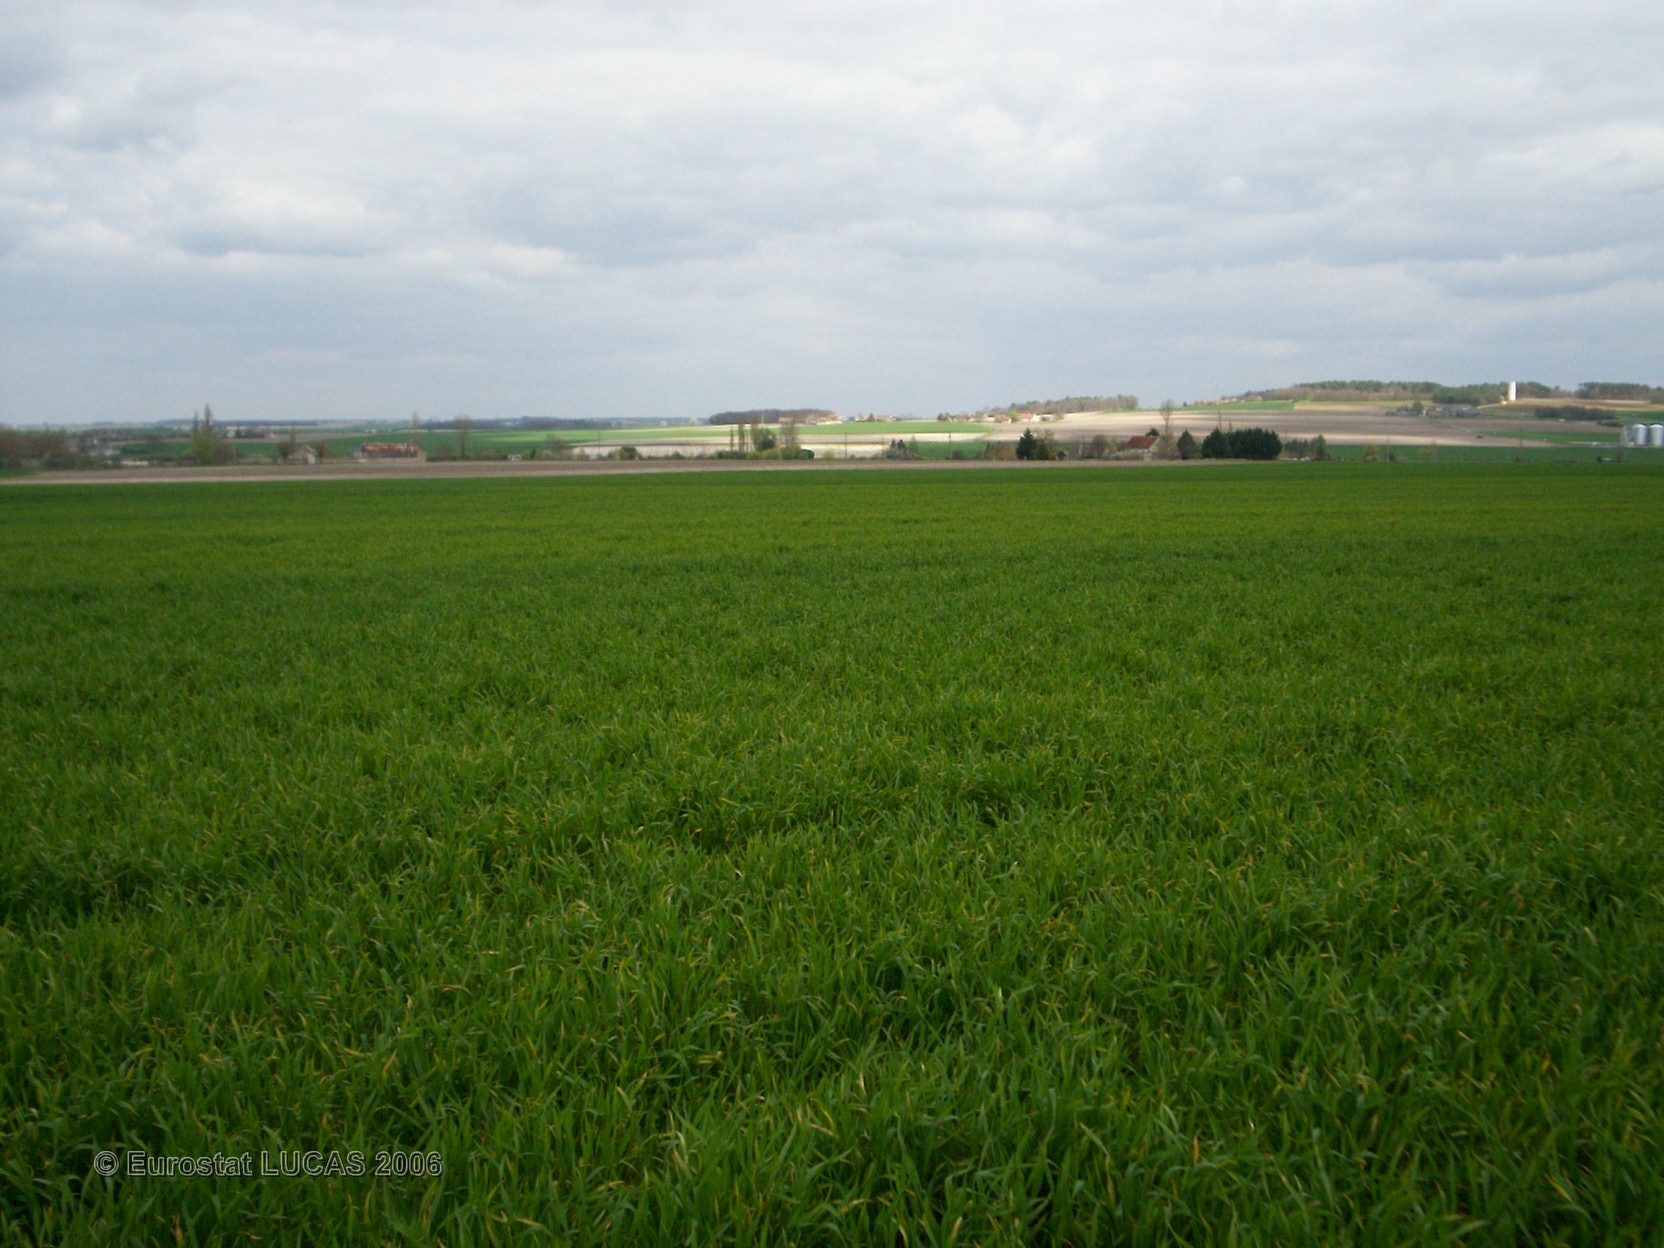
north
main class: Cropland
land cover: Common wheat
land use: Agriculture (excluding fallow land and kitchen gardens)
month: April
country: FR
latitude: 47.0418
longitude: 0.5971
